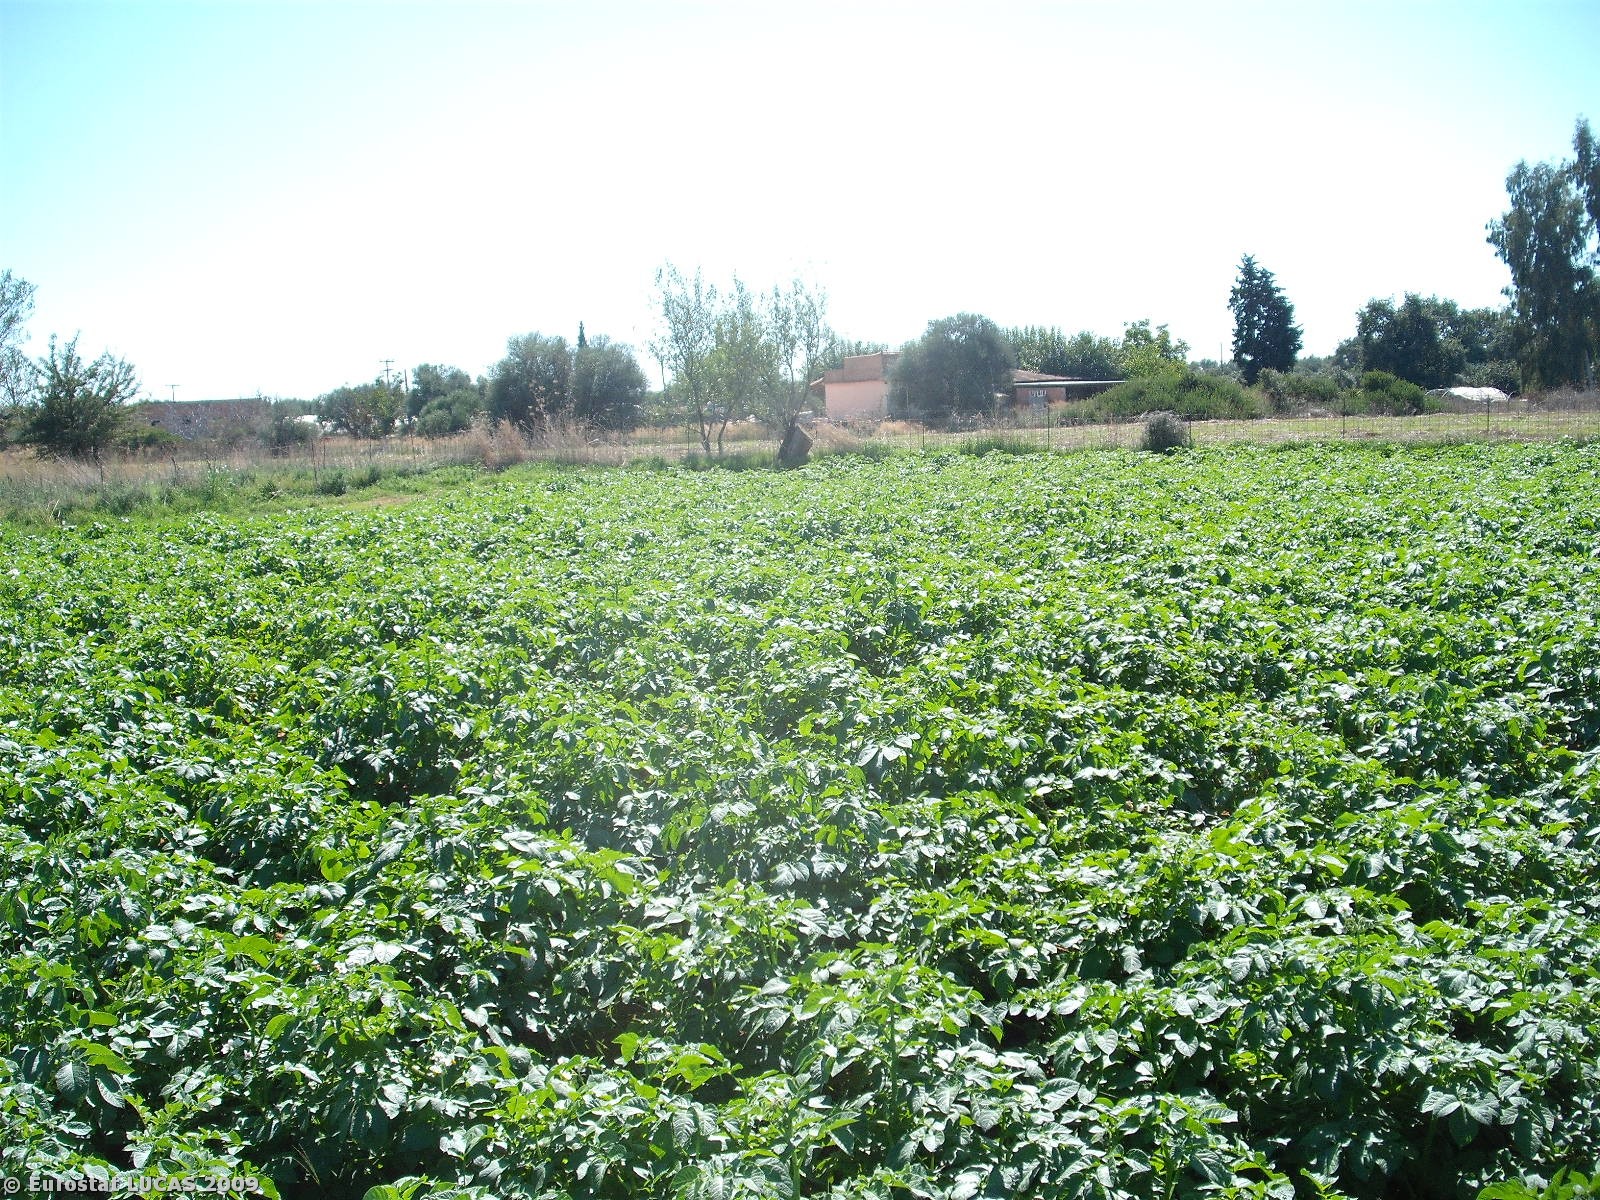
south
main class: Cropland
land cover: Potatoes
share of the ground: > 75 %
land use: Agriculture (excluding fallow land and kitchen gardens)
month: October
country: GR
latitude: 38.0430
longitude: 21.4376
